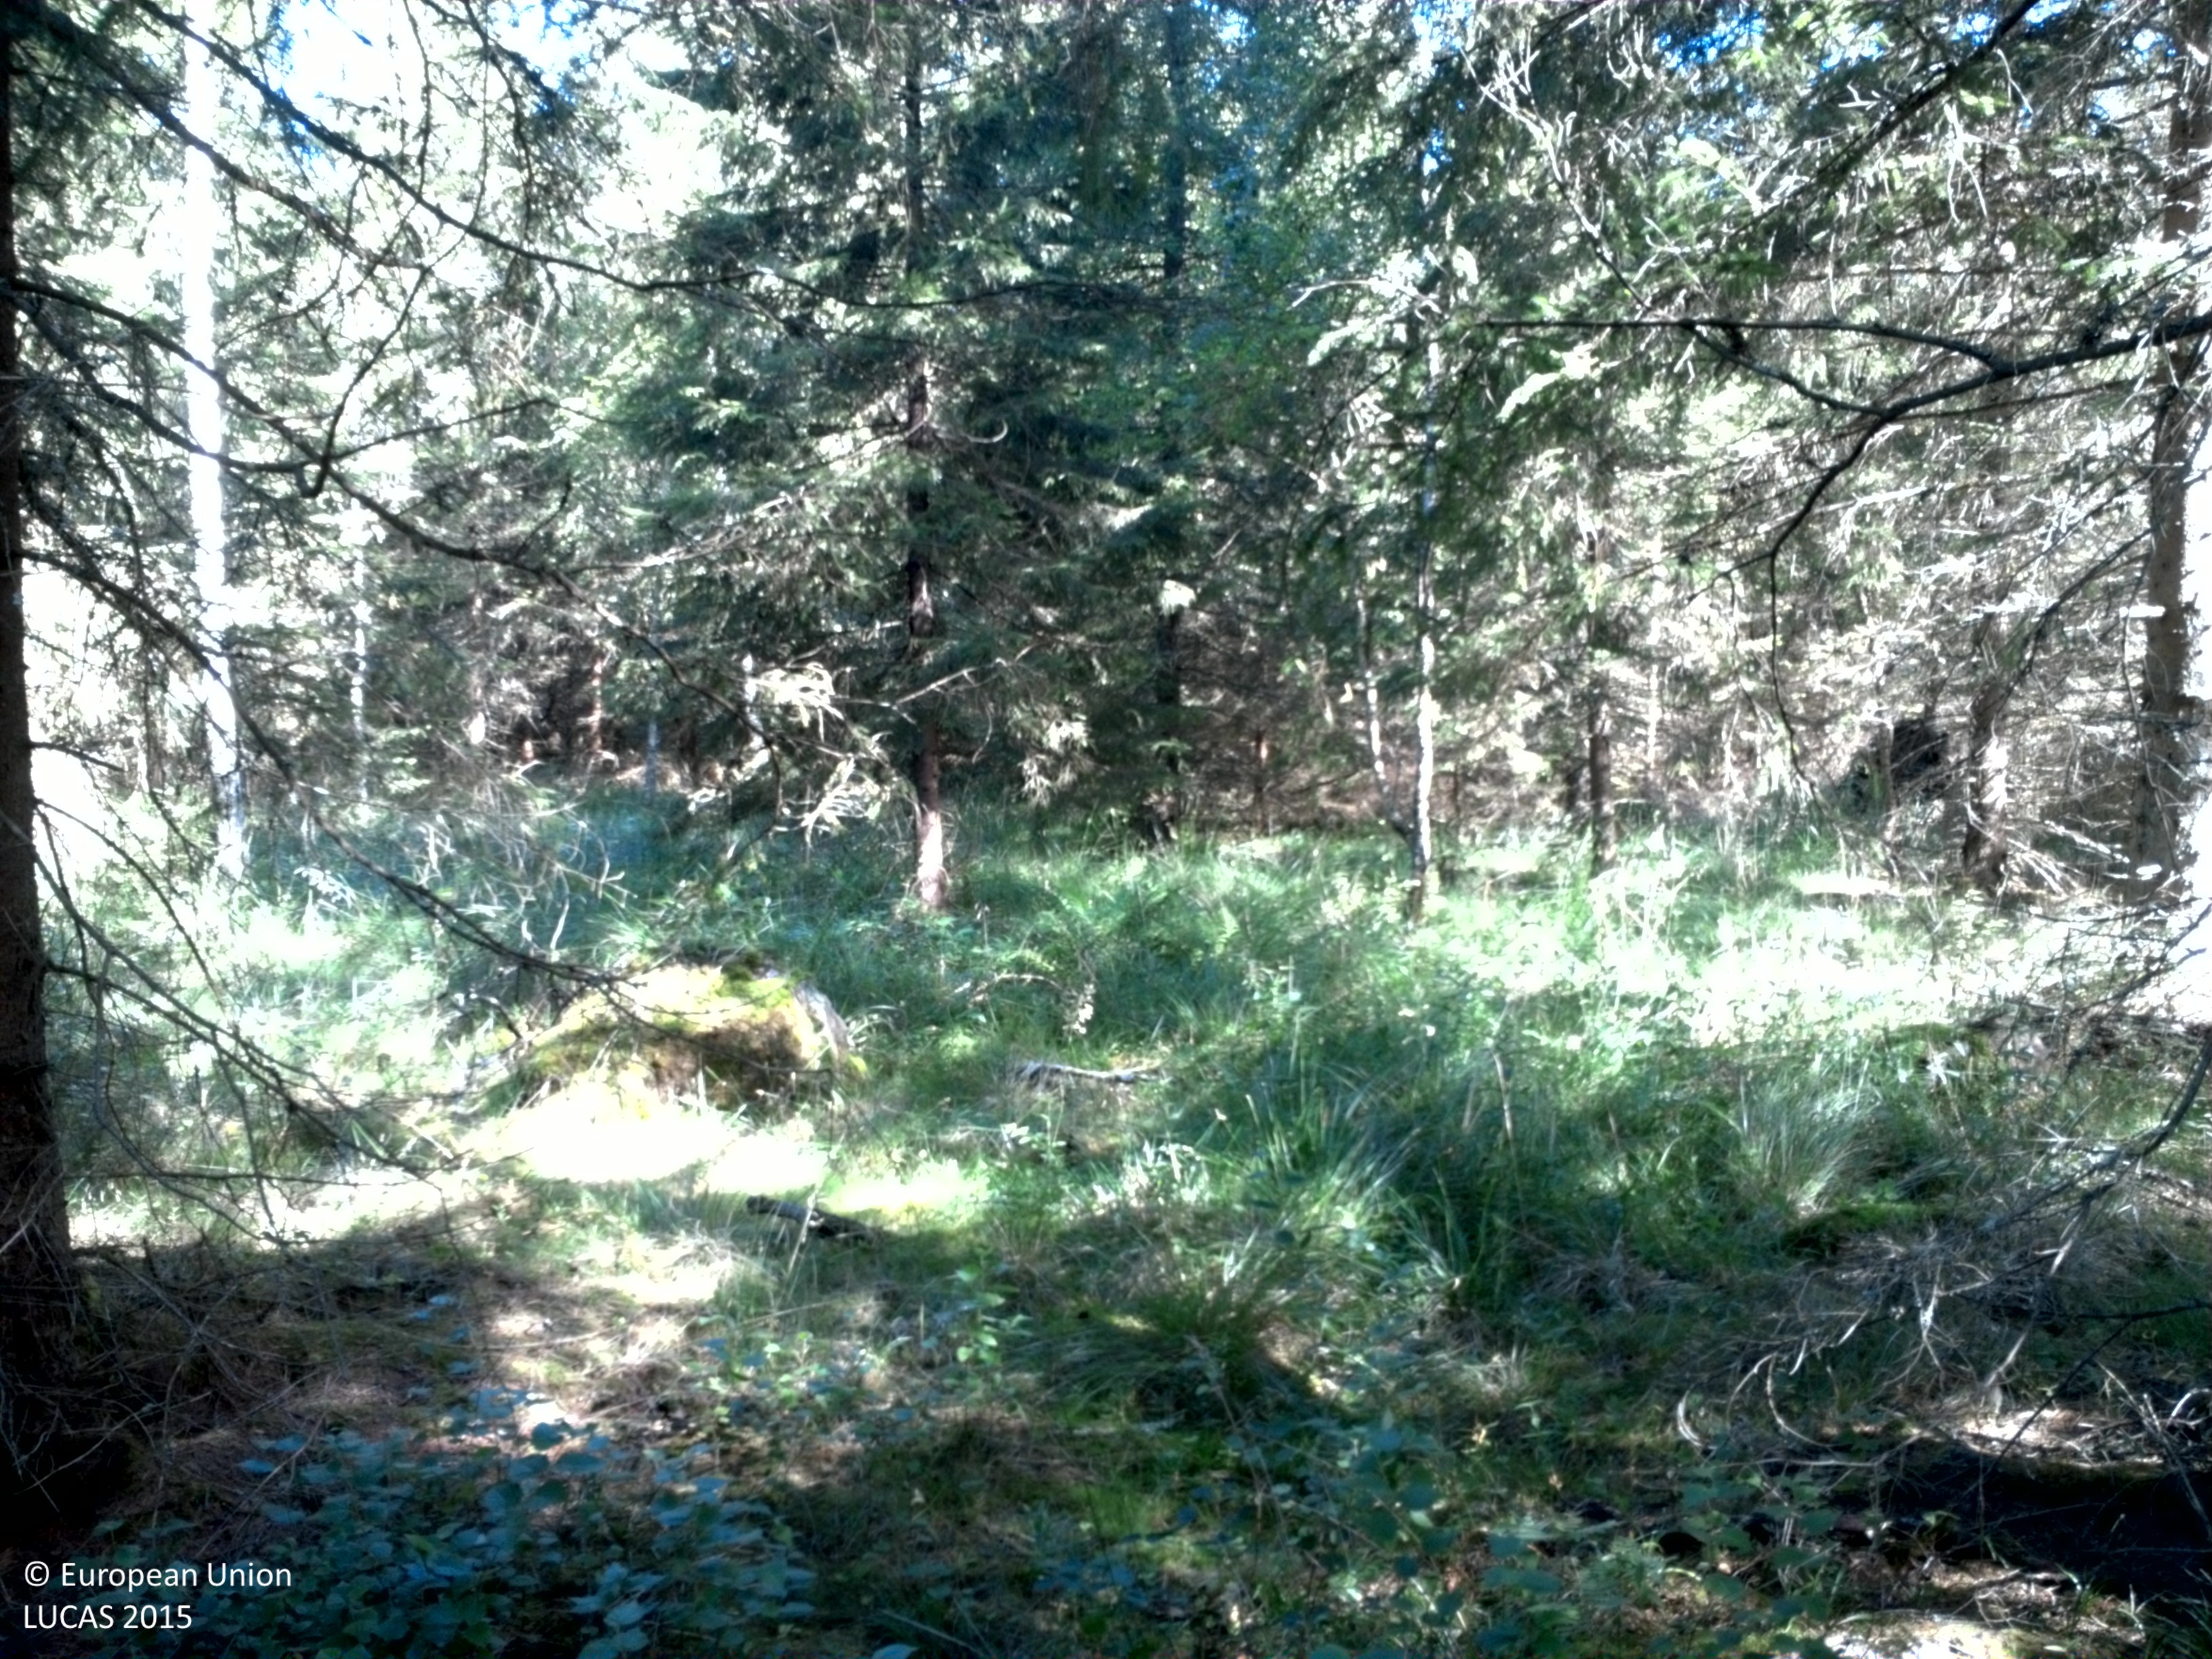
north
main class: Woodland
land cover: Spruce dominated coniferous woodland
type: boreal forest
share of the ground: 50 - 75 %
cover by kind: coniferous forest trees 70 %, lichens and mosses 25 %, herbaceous plants 5 %
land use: Forestry
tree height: > 5 m
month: August
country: SE
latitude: 58.2147
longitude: 13.3137
